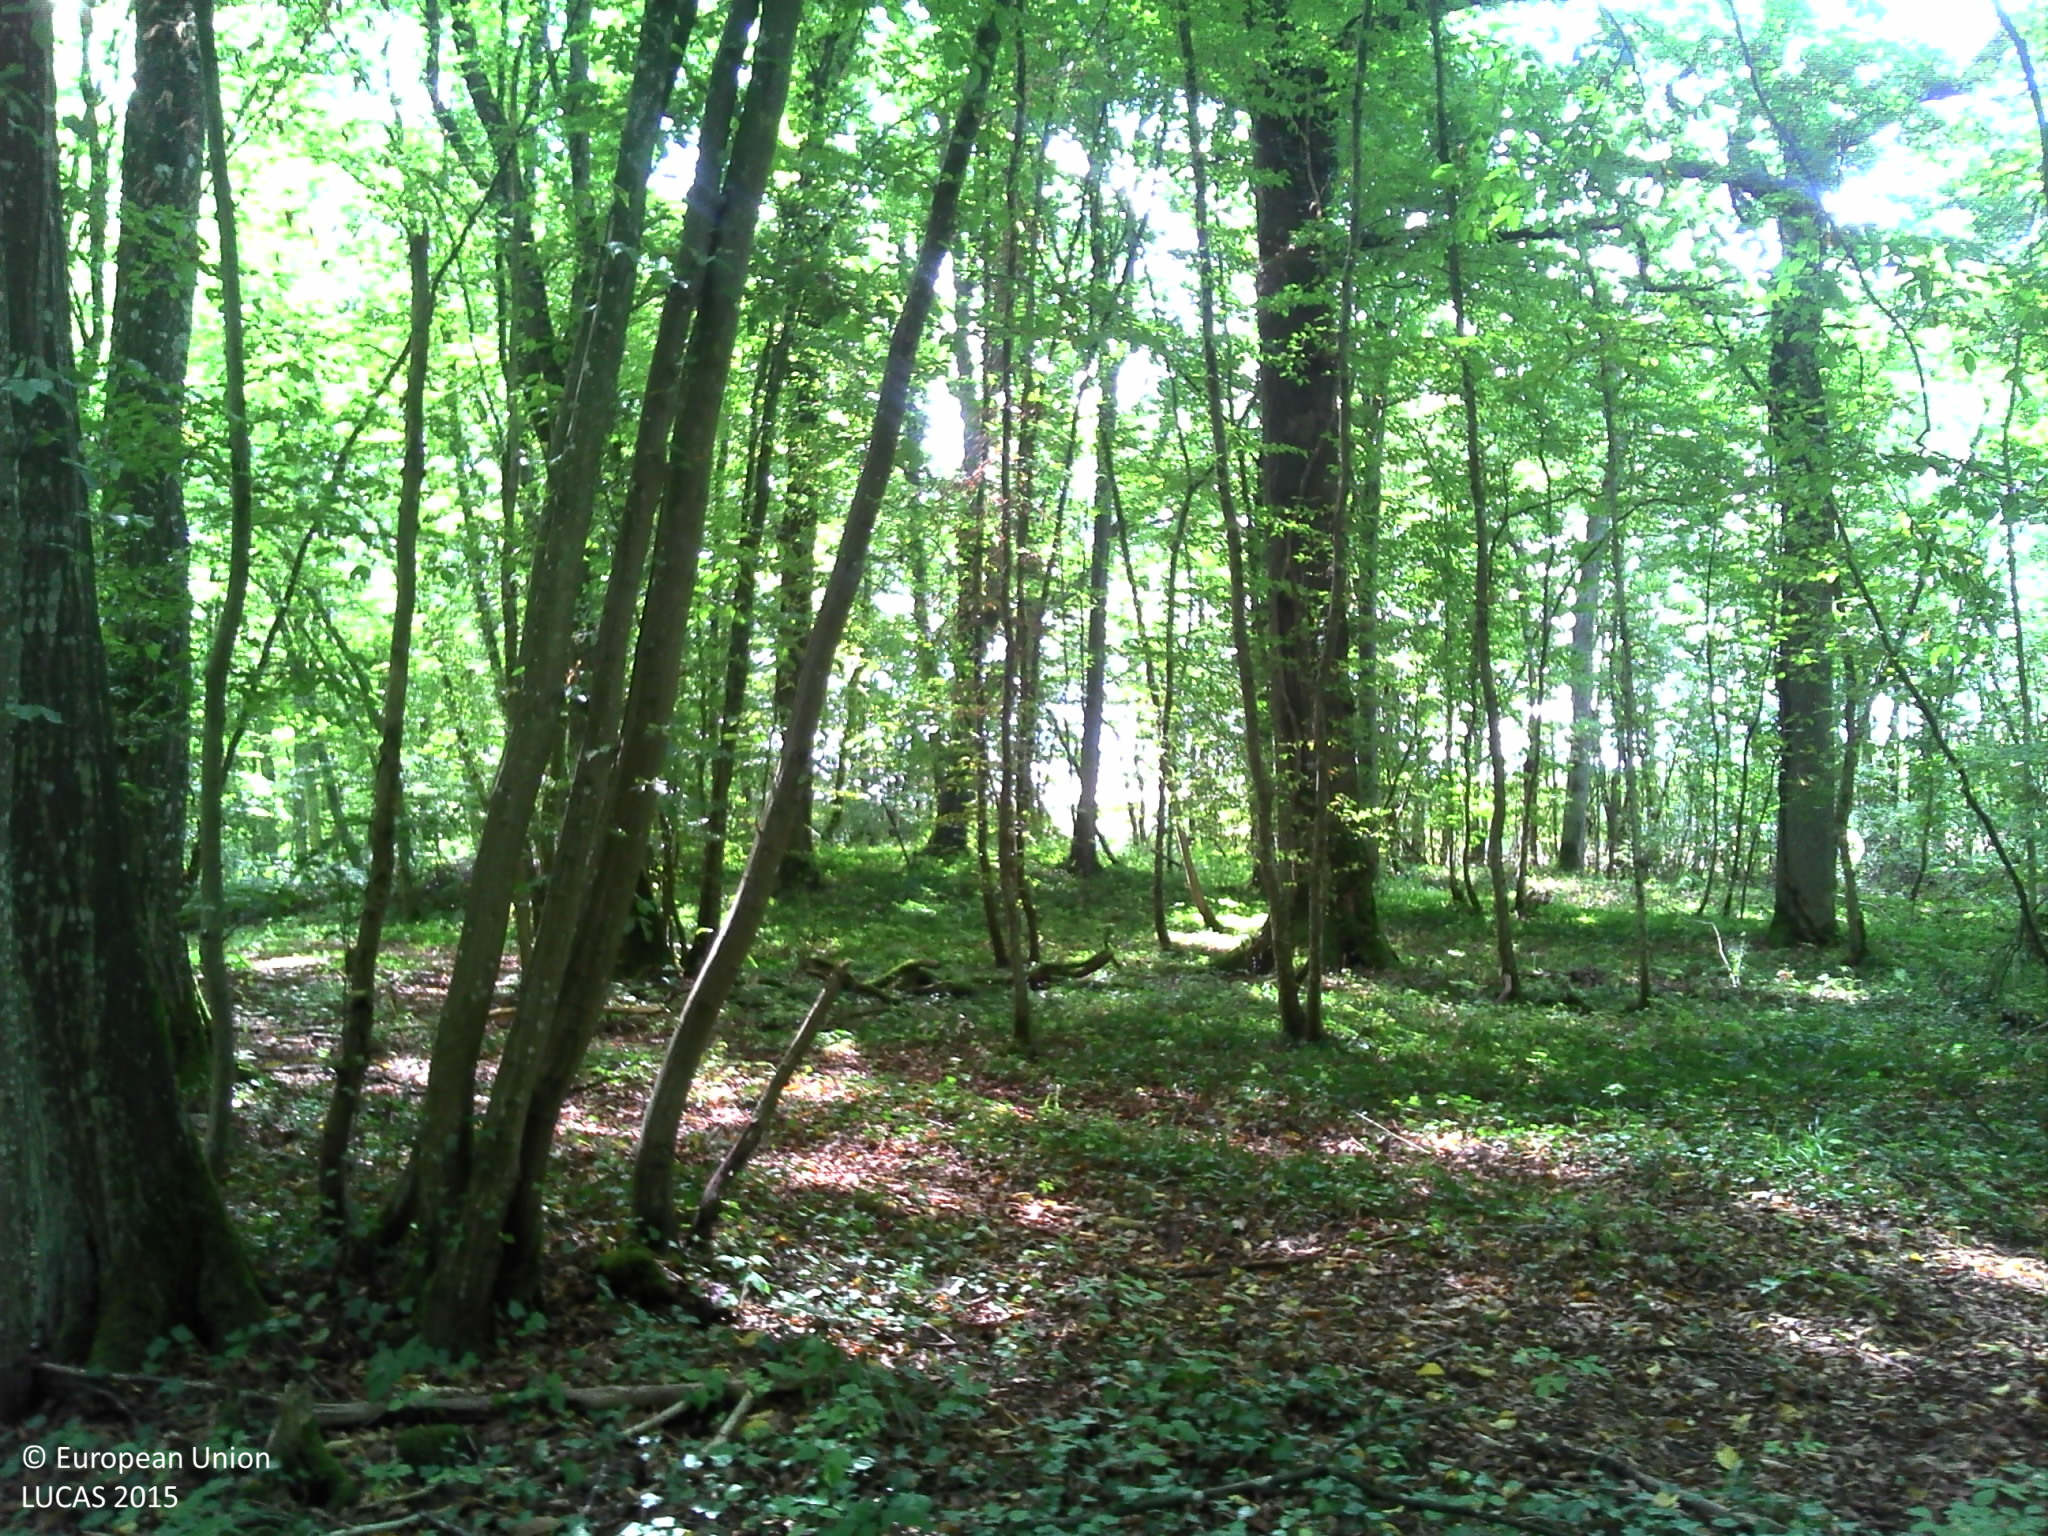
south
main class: Woodland
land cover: Broadleaved woodland
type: mesophytic deciduous forest
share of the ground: > 75 %
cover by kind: broadleaved forest trees 85 %, herbaceous plants 10 %, consolidated bare surface 5 %
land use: Forestry
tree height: > 5 m
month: September
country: FR
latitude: 48.7819
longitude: 6.0122
